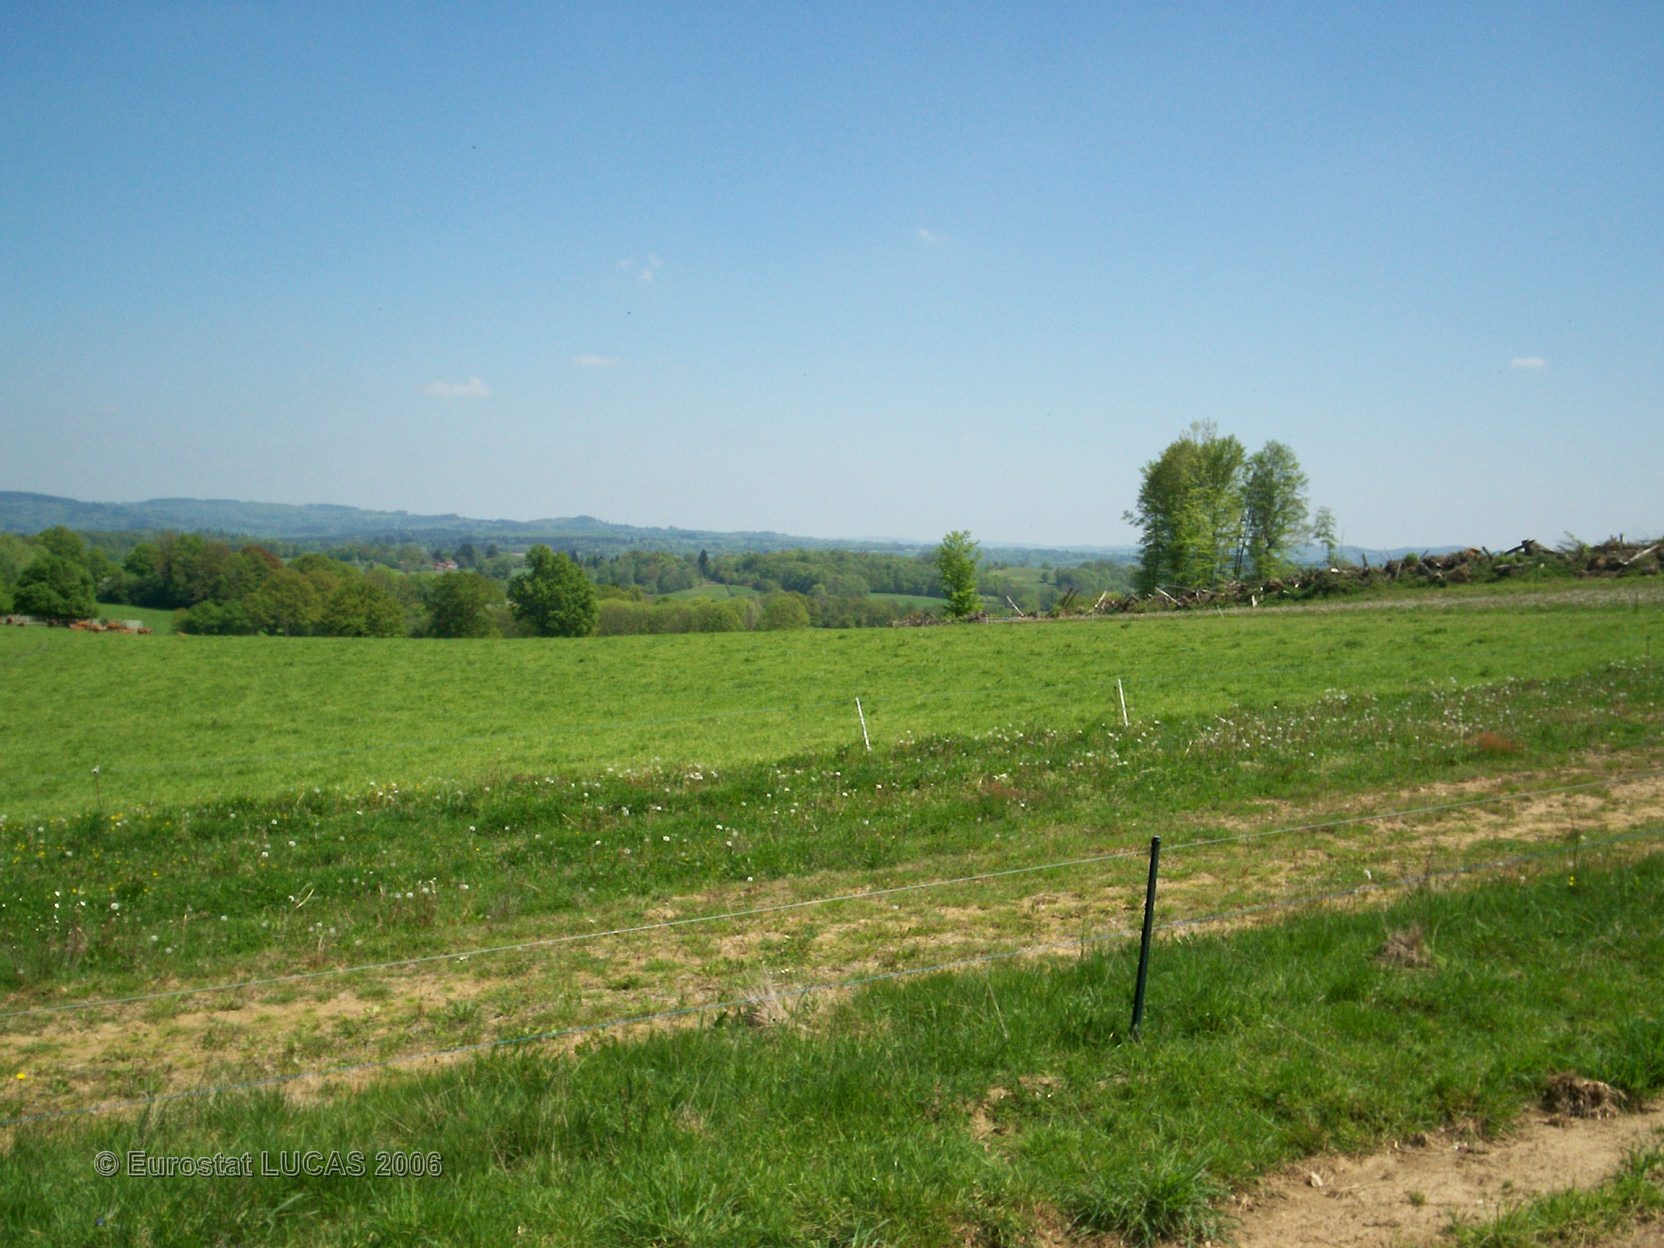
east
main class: Grassland
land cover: Grassland without tree/shrub cover
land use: Agriculture (excluding fallow land and kitchen gardens)
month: May
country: FR
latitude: 45.9792
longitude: 1.5374
